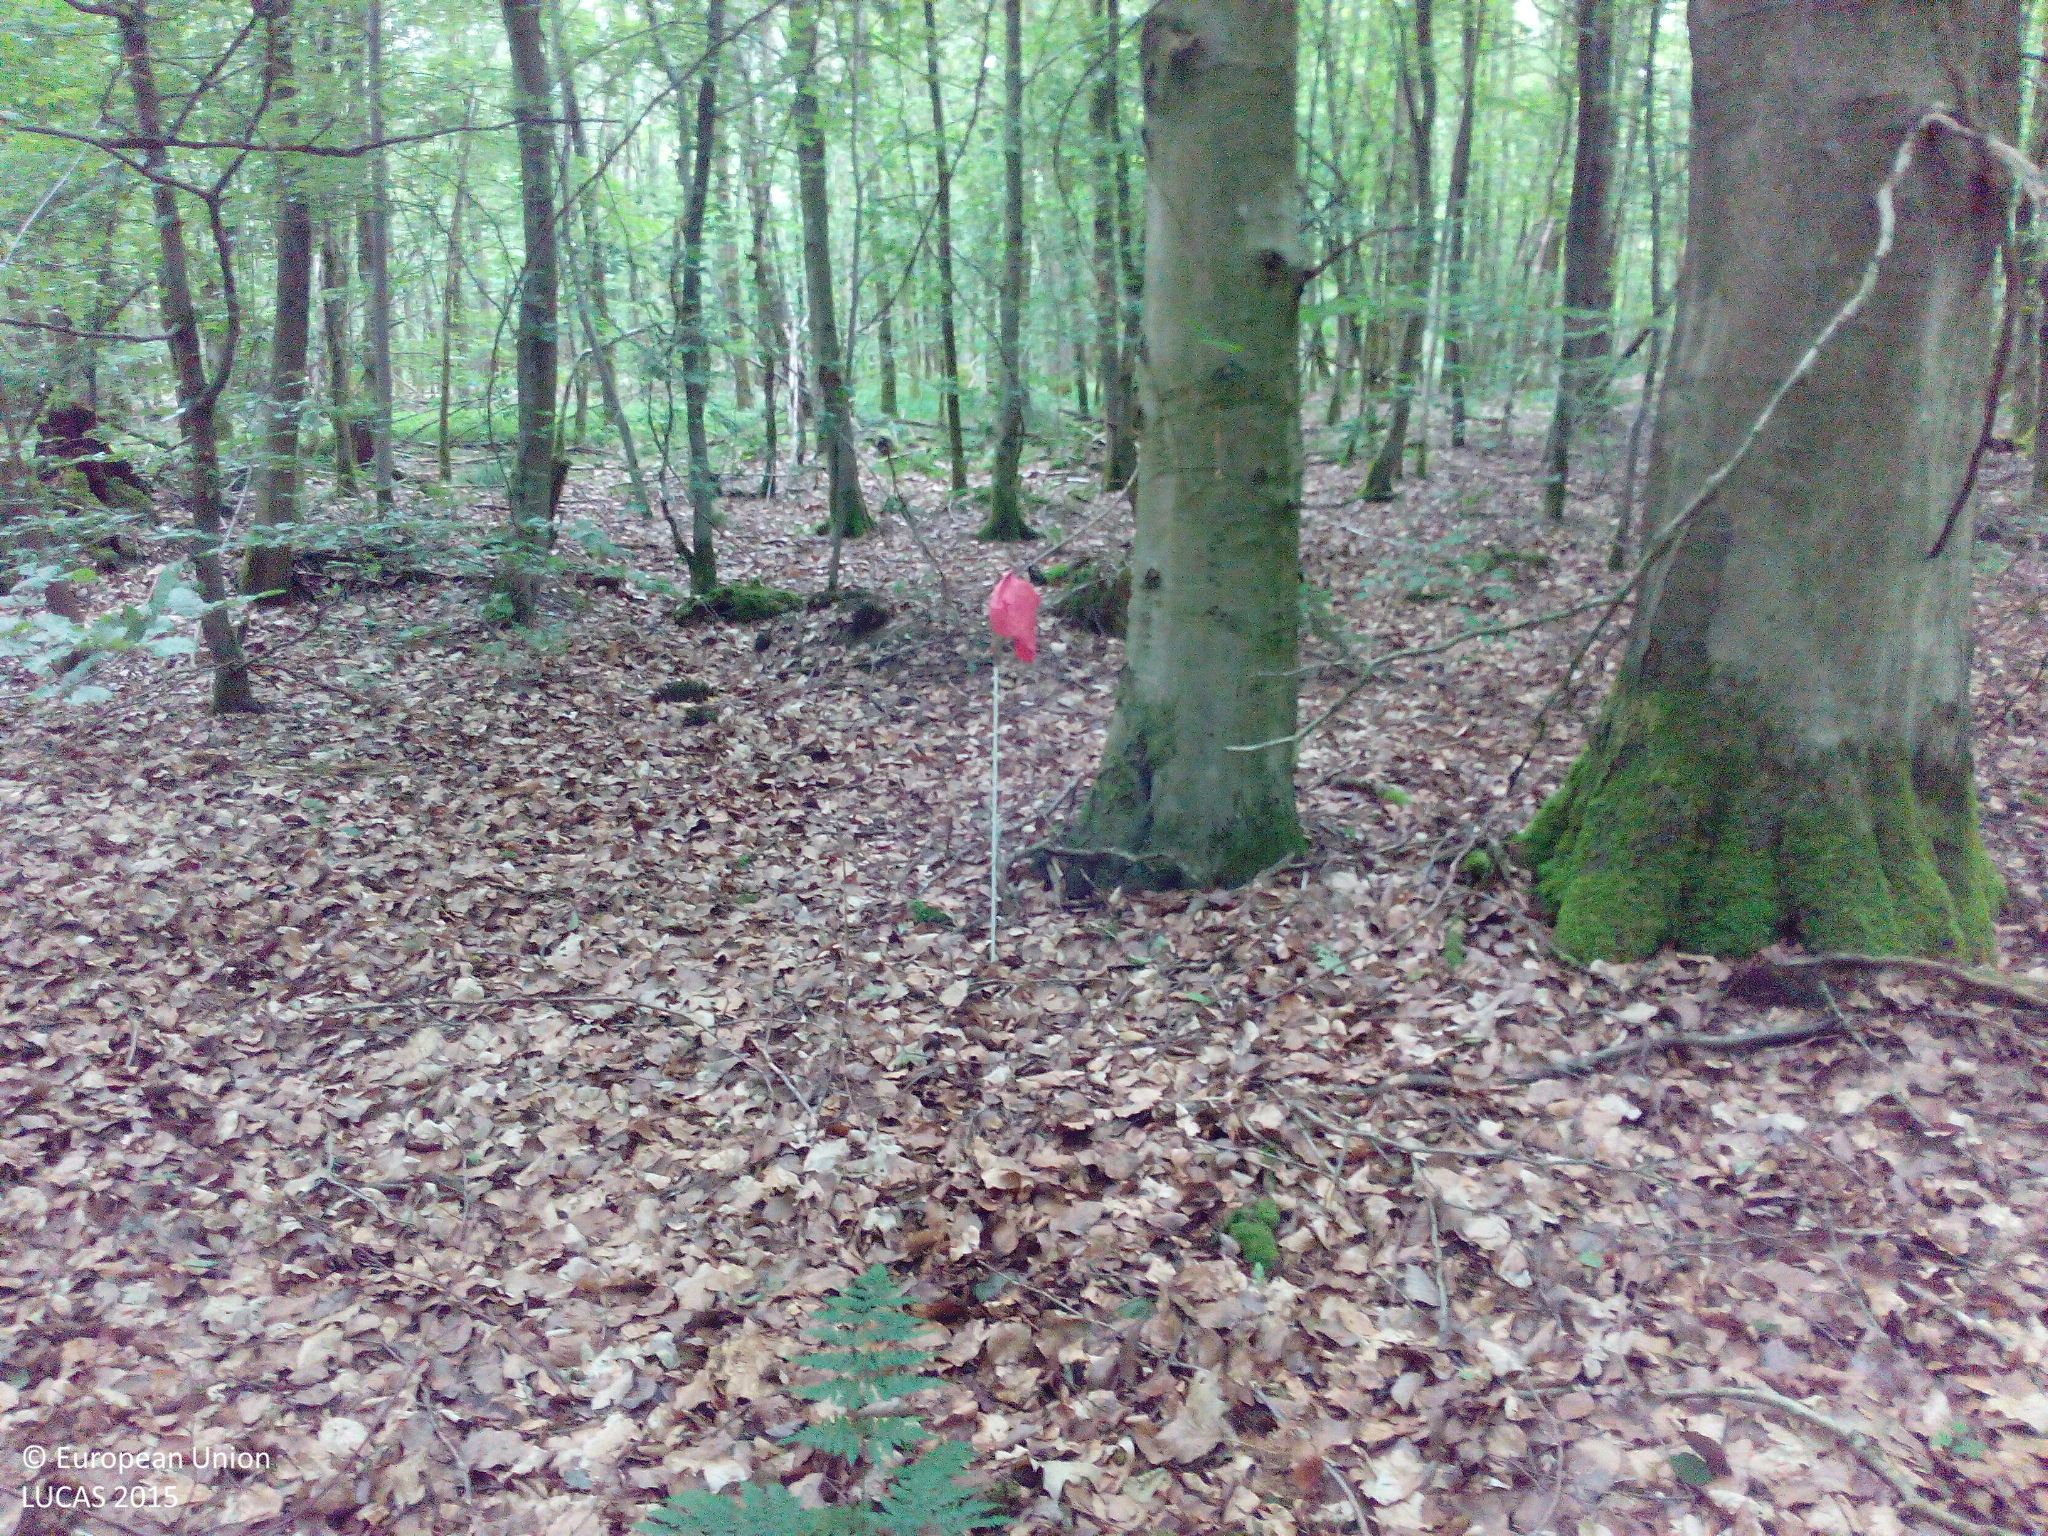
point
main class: Woodland
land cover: Spruce dominated mixed woodland
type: hemiboreal forest and nemoral coniferous forest and mixed broadleaved-coniferous forest
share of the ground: > 75 %
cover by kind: broadleaved forest trees 70 %, coniferous forest trees 25 %, unconsolidated bare surface 5 %
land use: Forestry
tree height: > 5 m
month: June
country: DE
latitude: 49.2835
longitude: 9.4091
